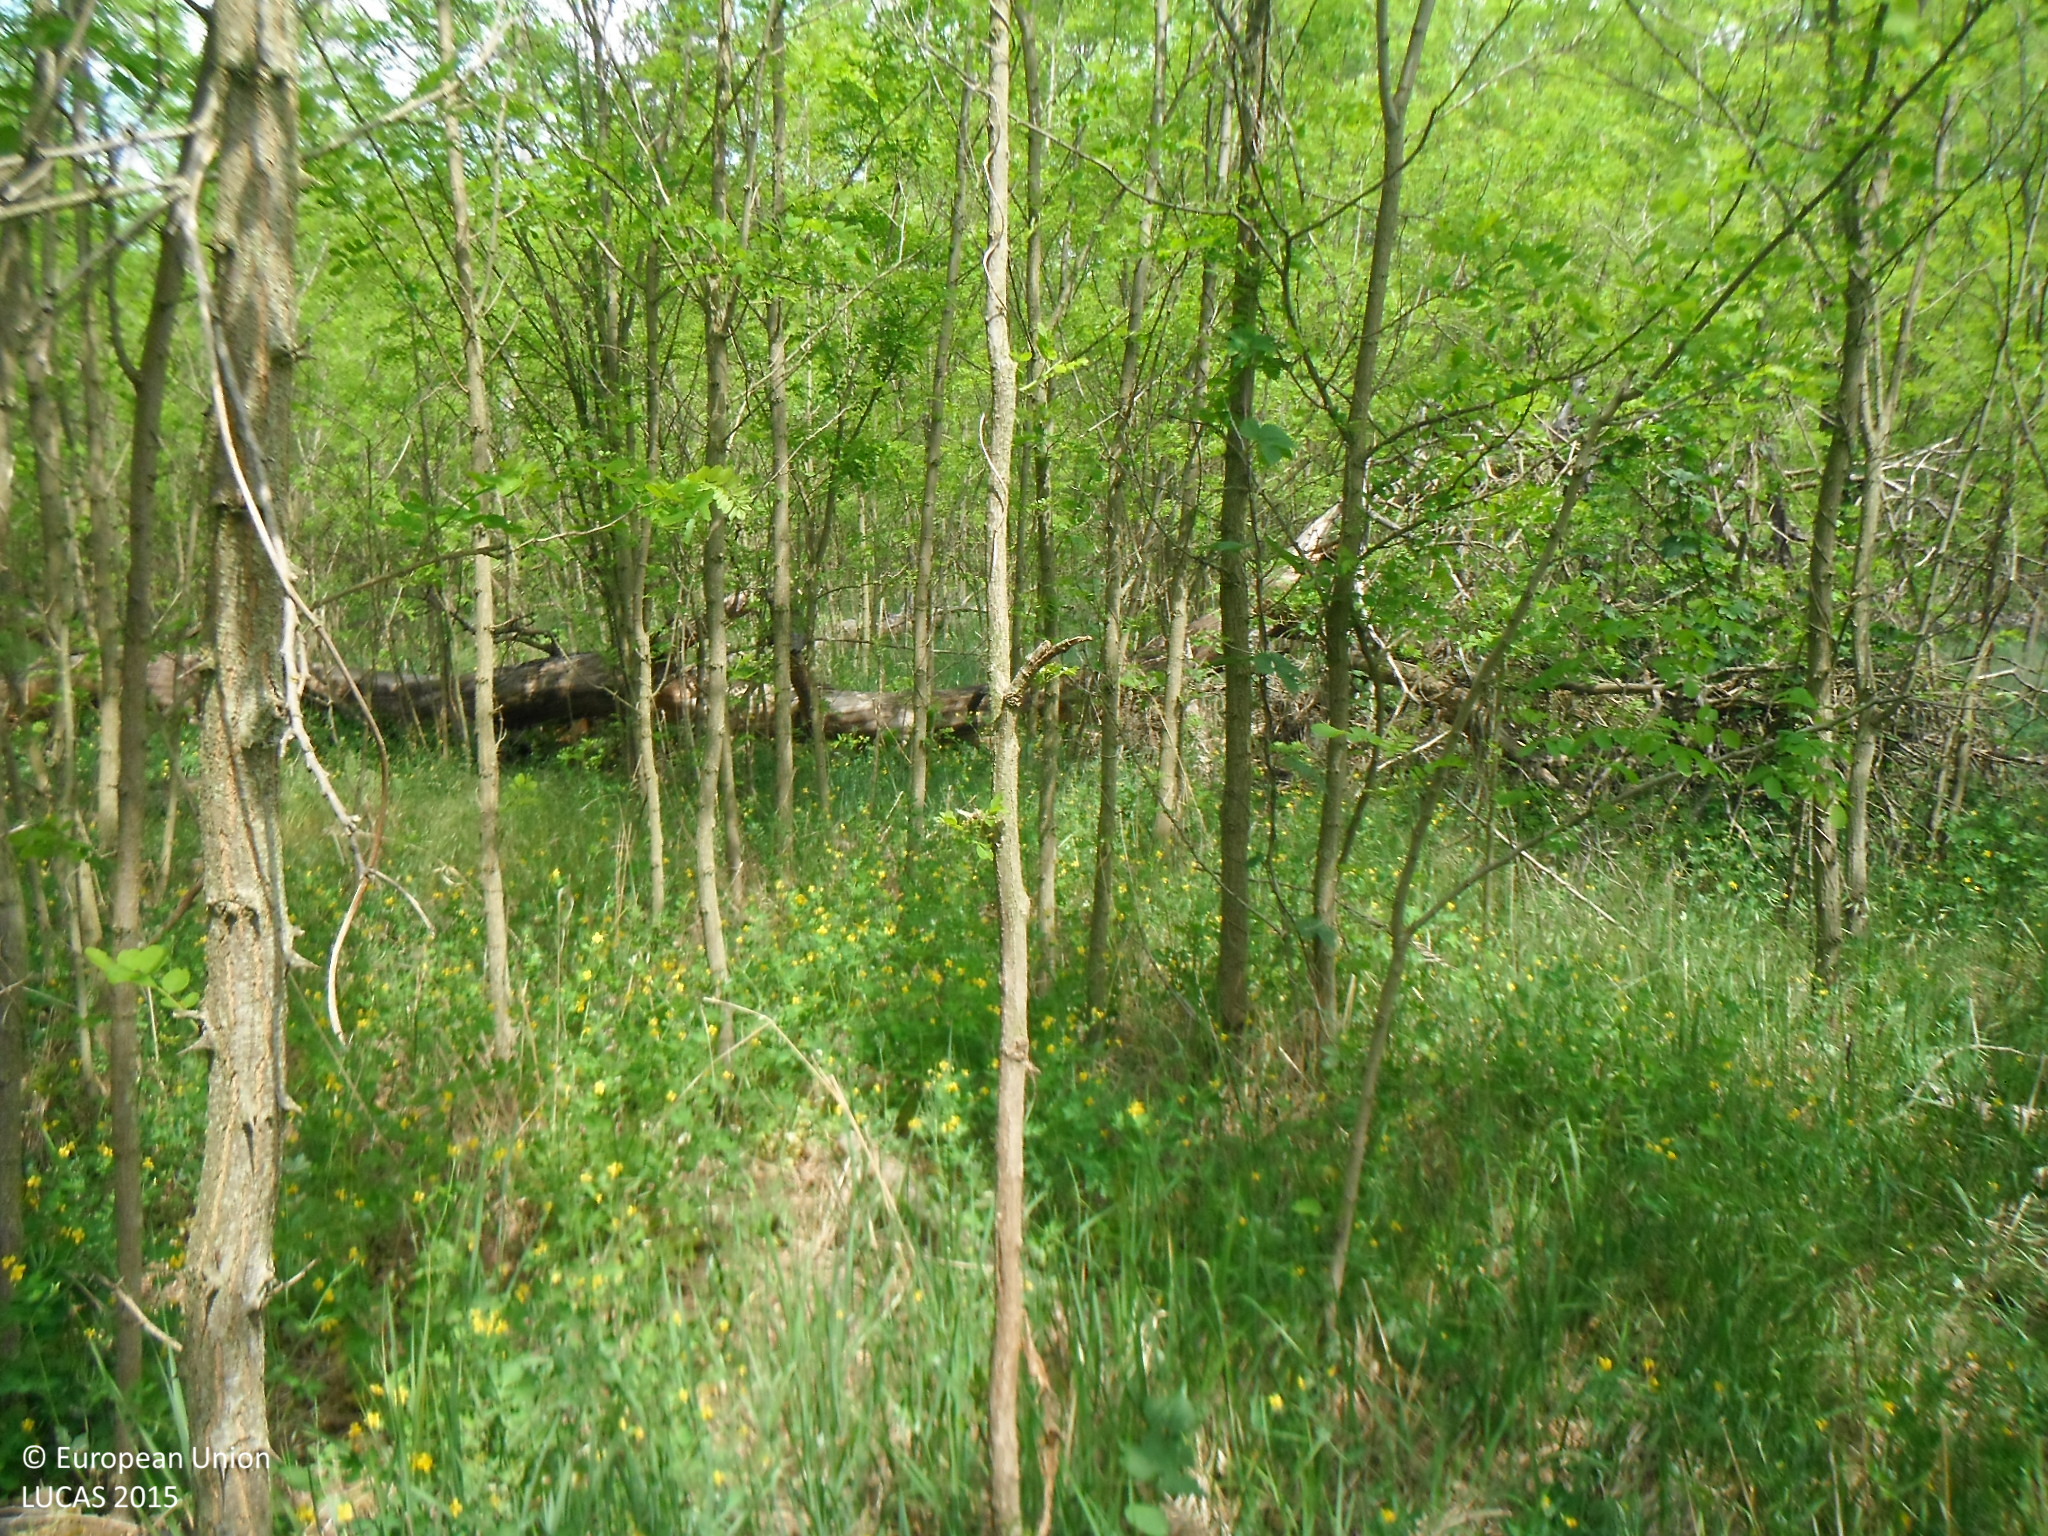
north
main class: Woodland
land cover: Broadleaved woodland
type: exotic forest
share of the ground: 50 - 75 %
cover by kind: broadleaved forest trees 60 %, shrubs 20 %, herbaceous plants 20 %
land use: Forestry
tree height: > 5 m
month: May
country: SK
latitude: 48.4218
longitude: 16.9127
